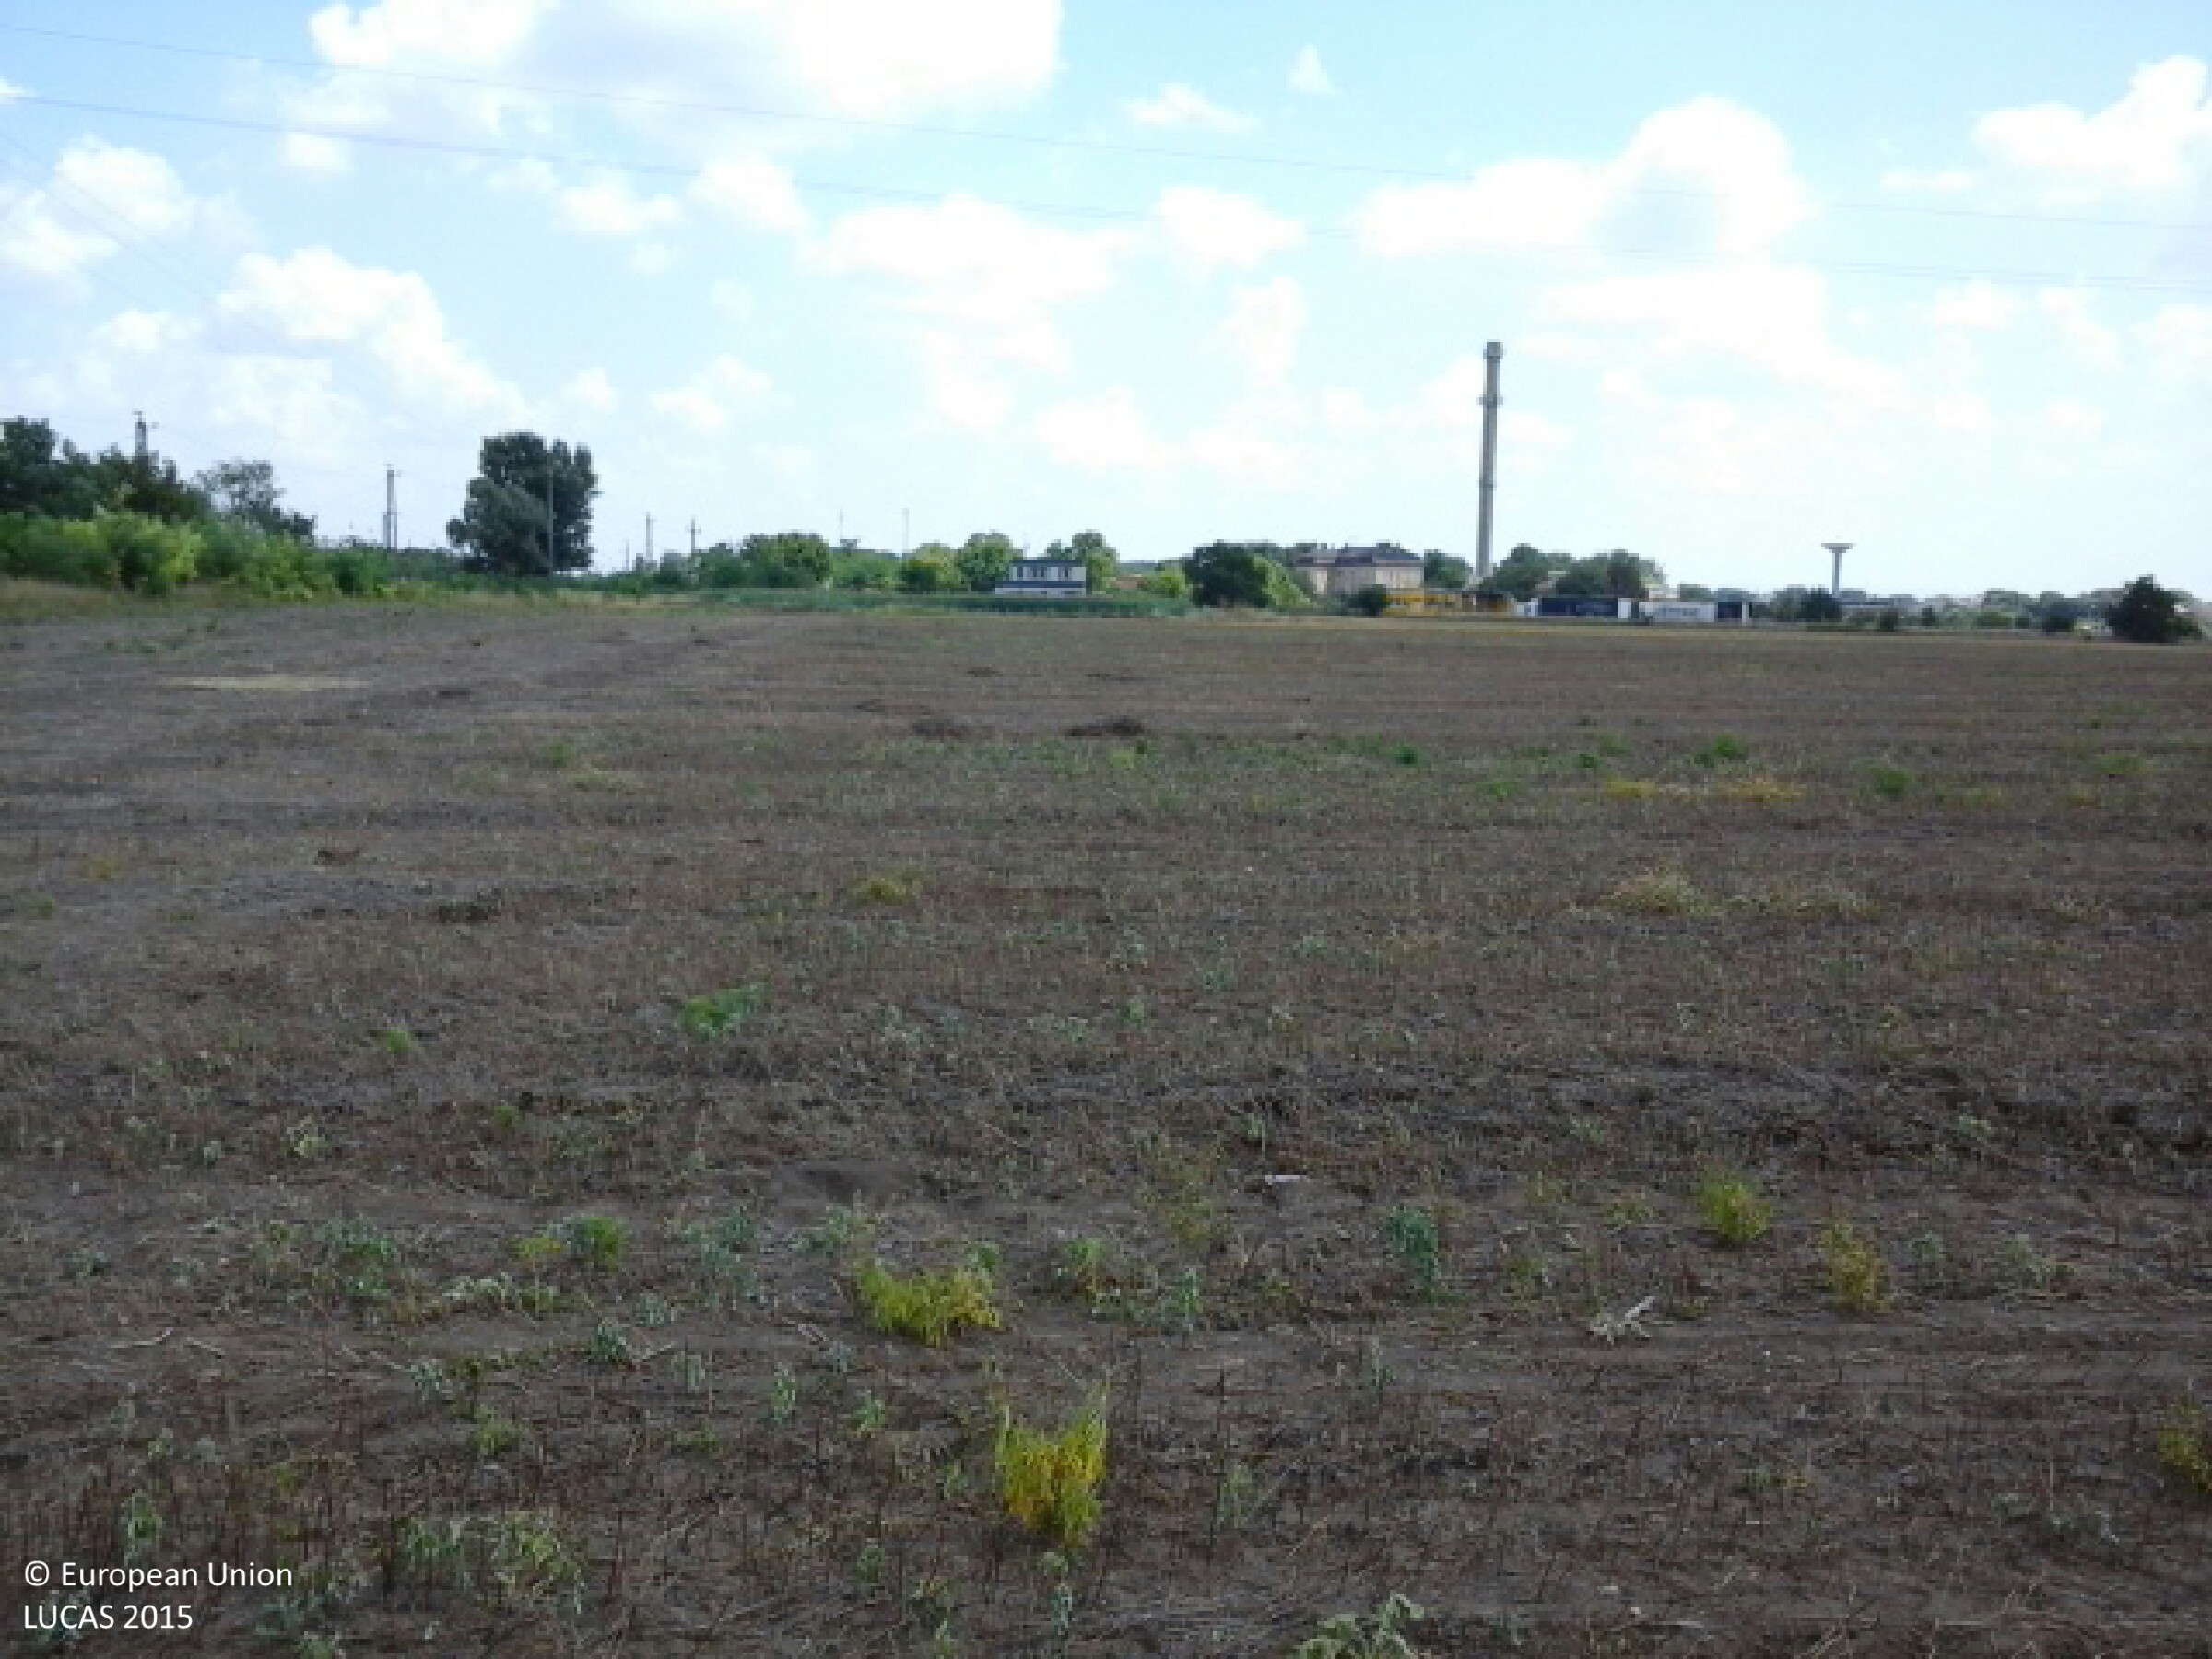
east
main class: Cropland
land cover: Common wheat
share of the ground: > 75 %
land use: Agriculture (excluding fallow land and kitchen gardens)
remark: Harvested field
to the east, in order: Common wheat; Electric lines; Common wheat; Maize; Fences; Grass margins; Tracks
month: August
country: HU
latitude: 47.7158
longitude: 17.9959
